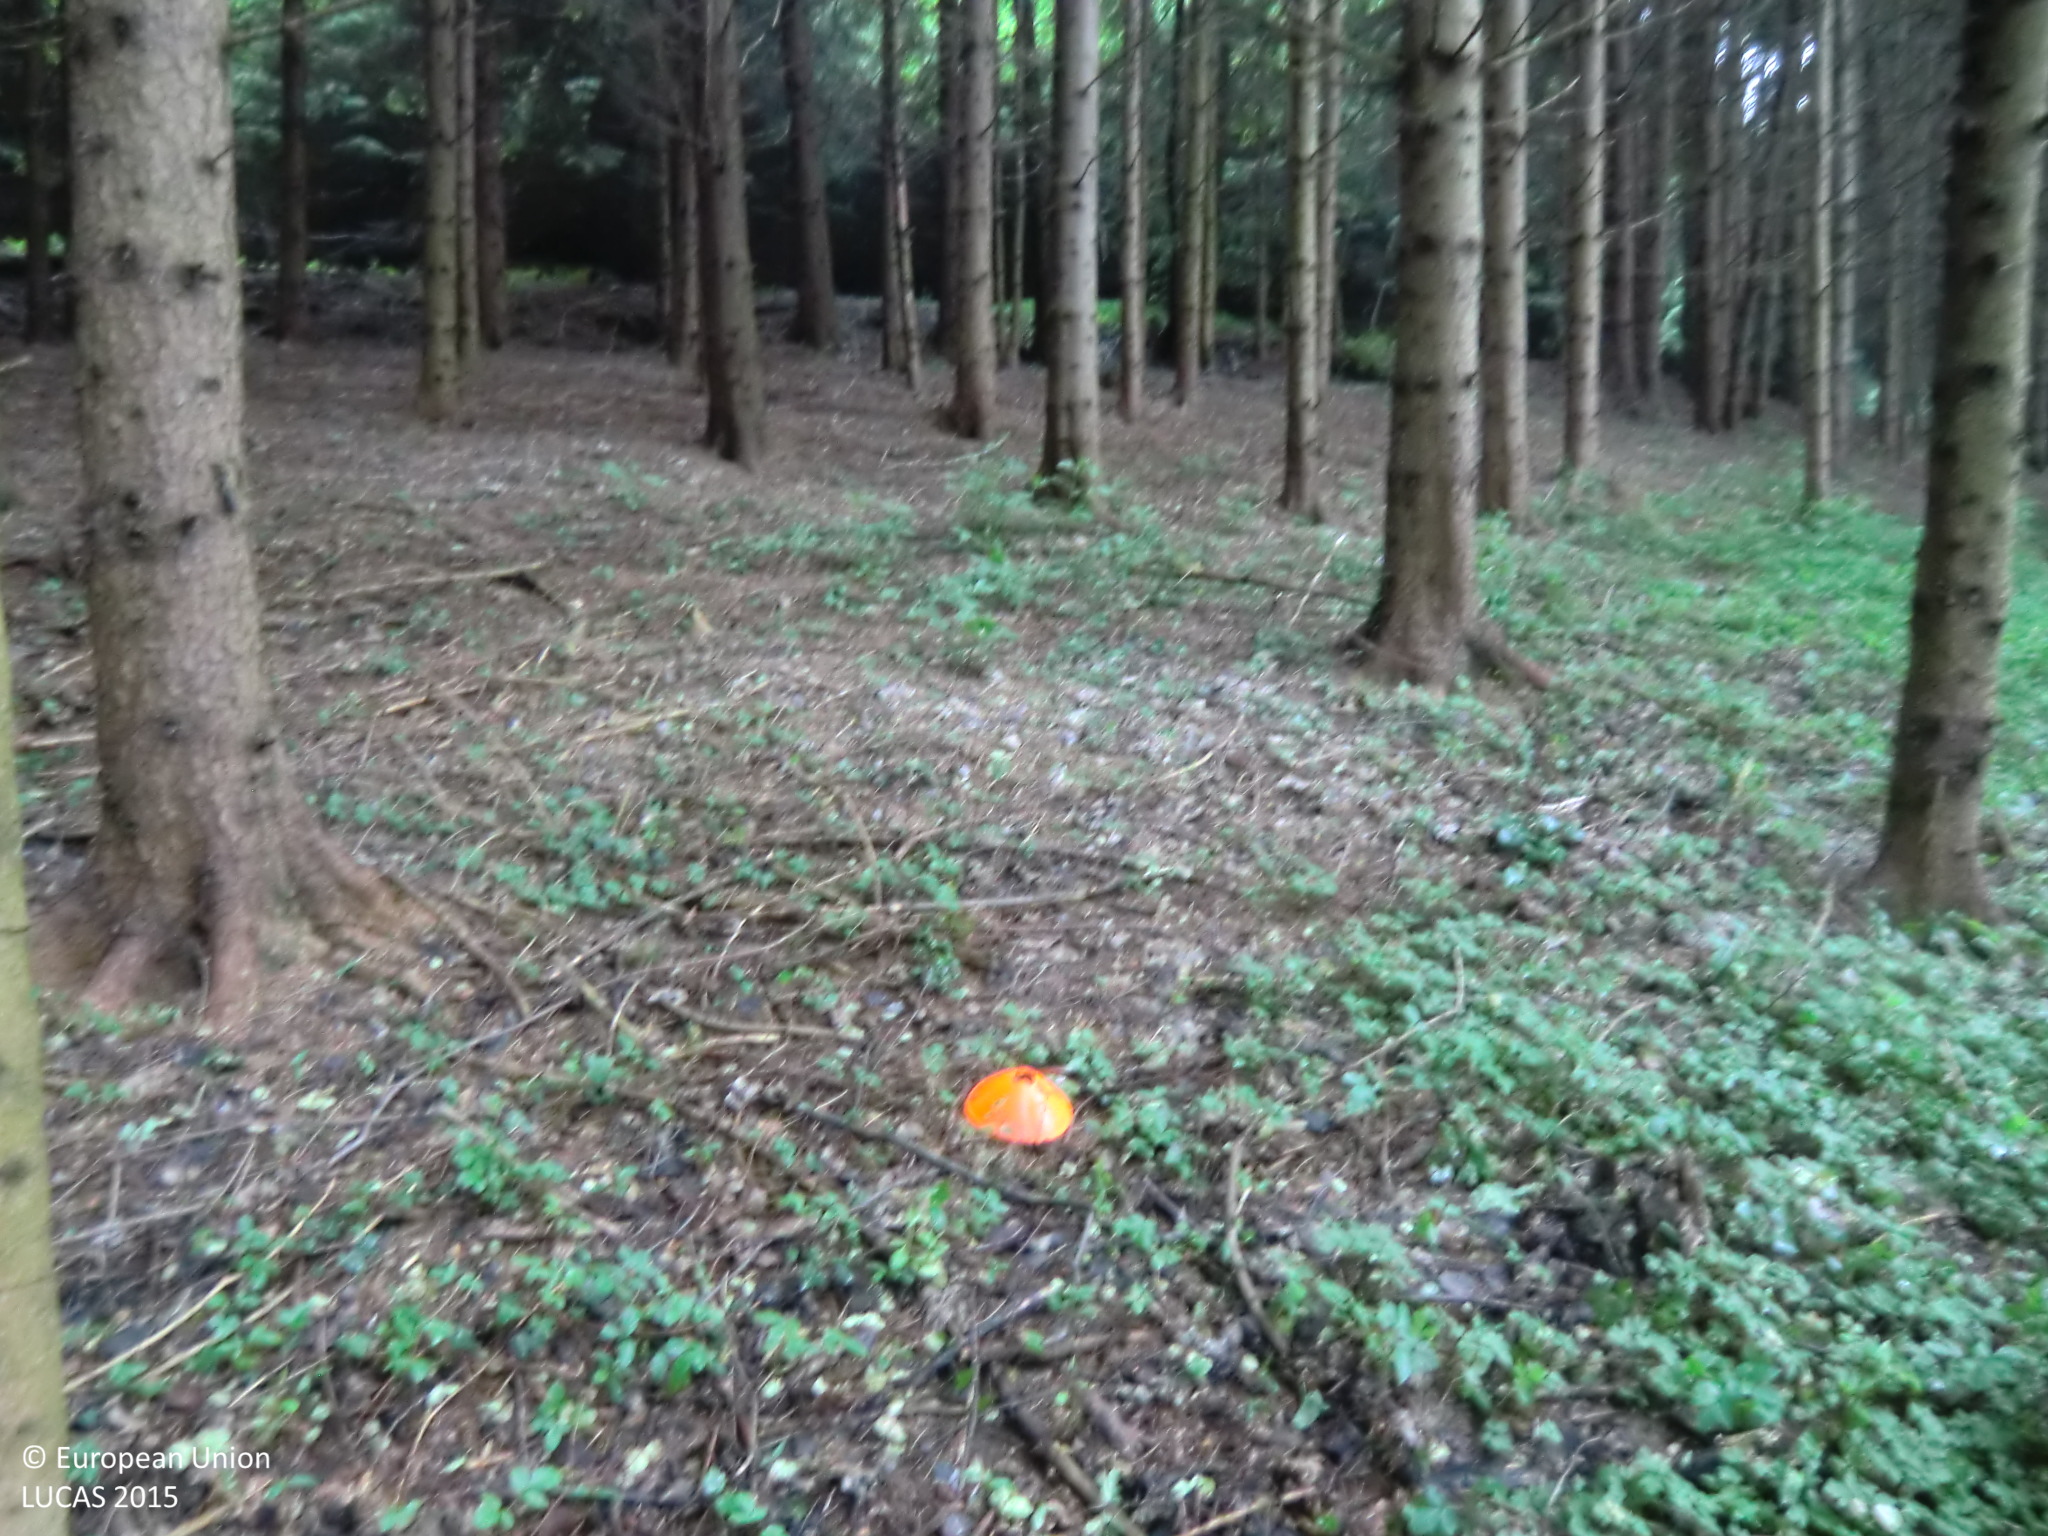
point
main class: Woodland
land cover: Spruce dominated coniferous woodland
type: hemiboreal forest and nemoral coniferous forest and mixed broadleaved-coniferous forest
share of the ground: > 75 %
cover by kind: coniferous forest trees 70 %, broadleaved forest trees 20 %, herbaceous plants 10 %
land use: Forestry
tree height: > 5 m
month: May
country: AT
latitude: 47.3413
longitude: 15.9444
